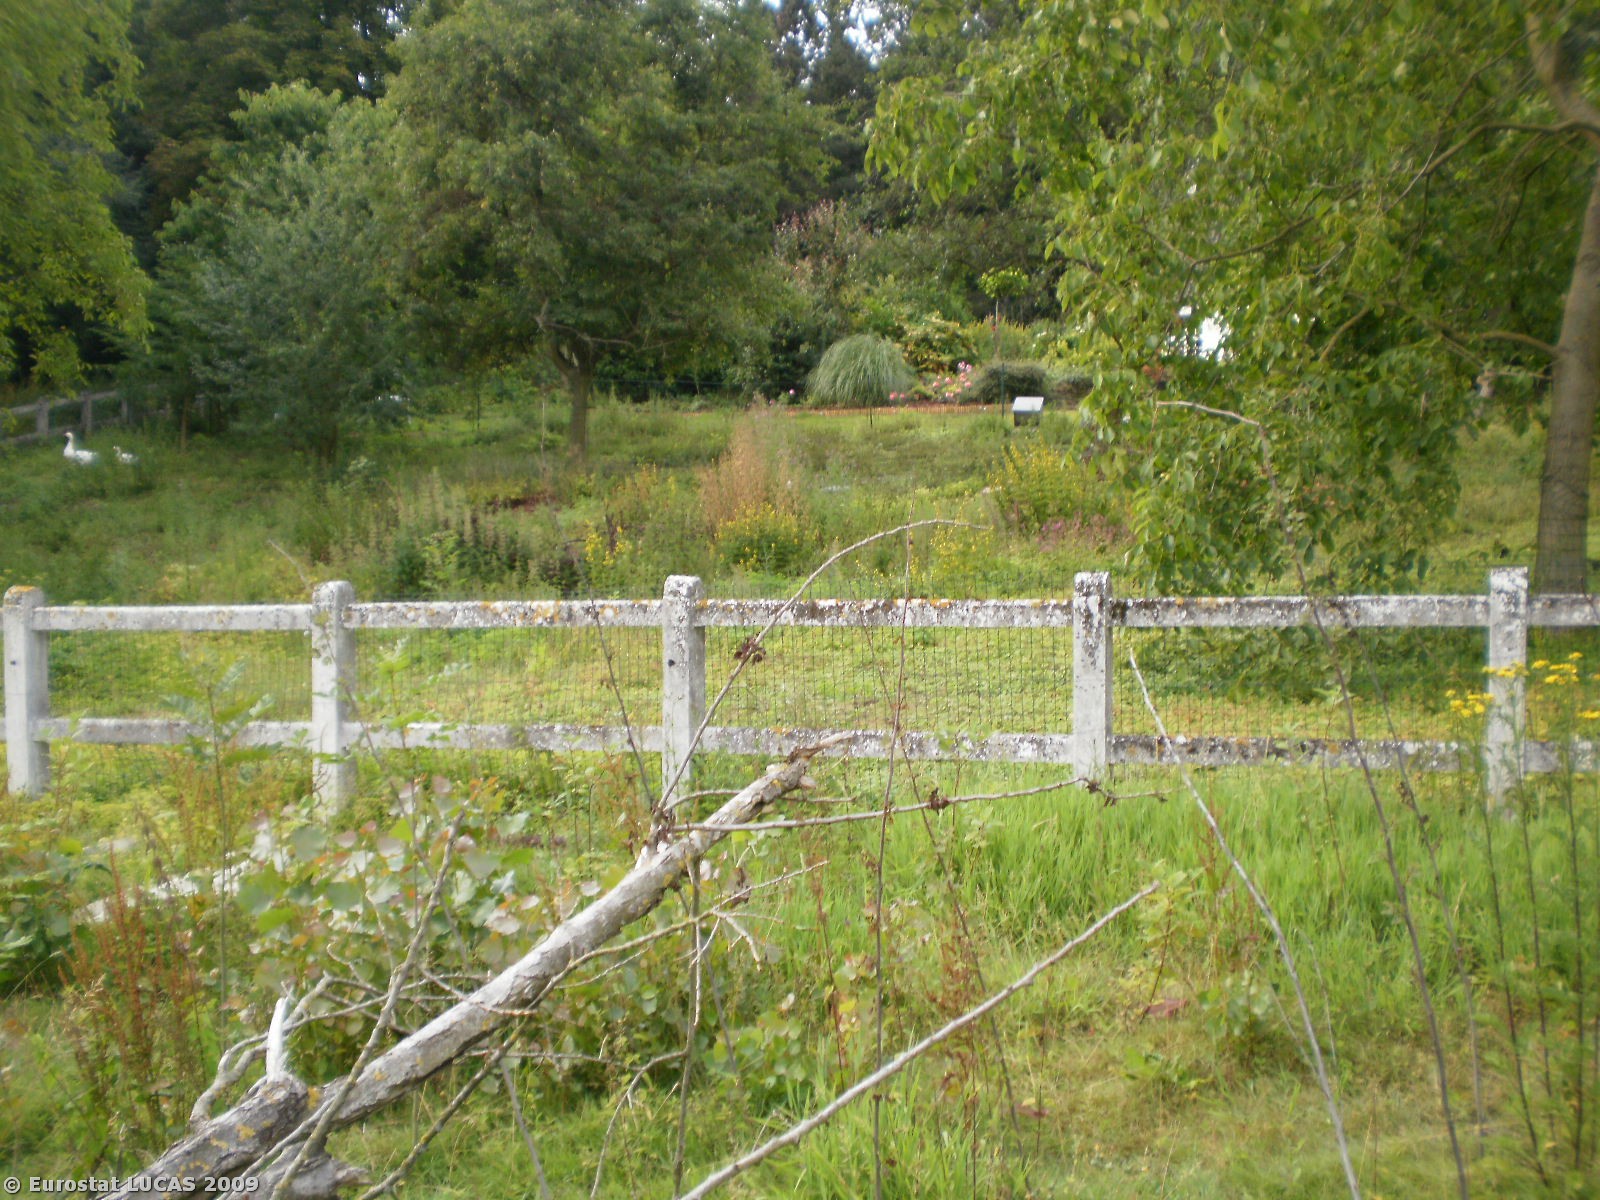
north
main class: Woodland
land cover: Broadleaved woodland
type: acidophilous oak and oak-birch forest
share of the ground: > 75 %
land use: Forestry
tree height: > 5 m
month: July
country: BE
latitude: 50.9009
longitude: 4.1790
